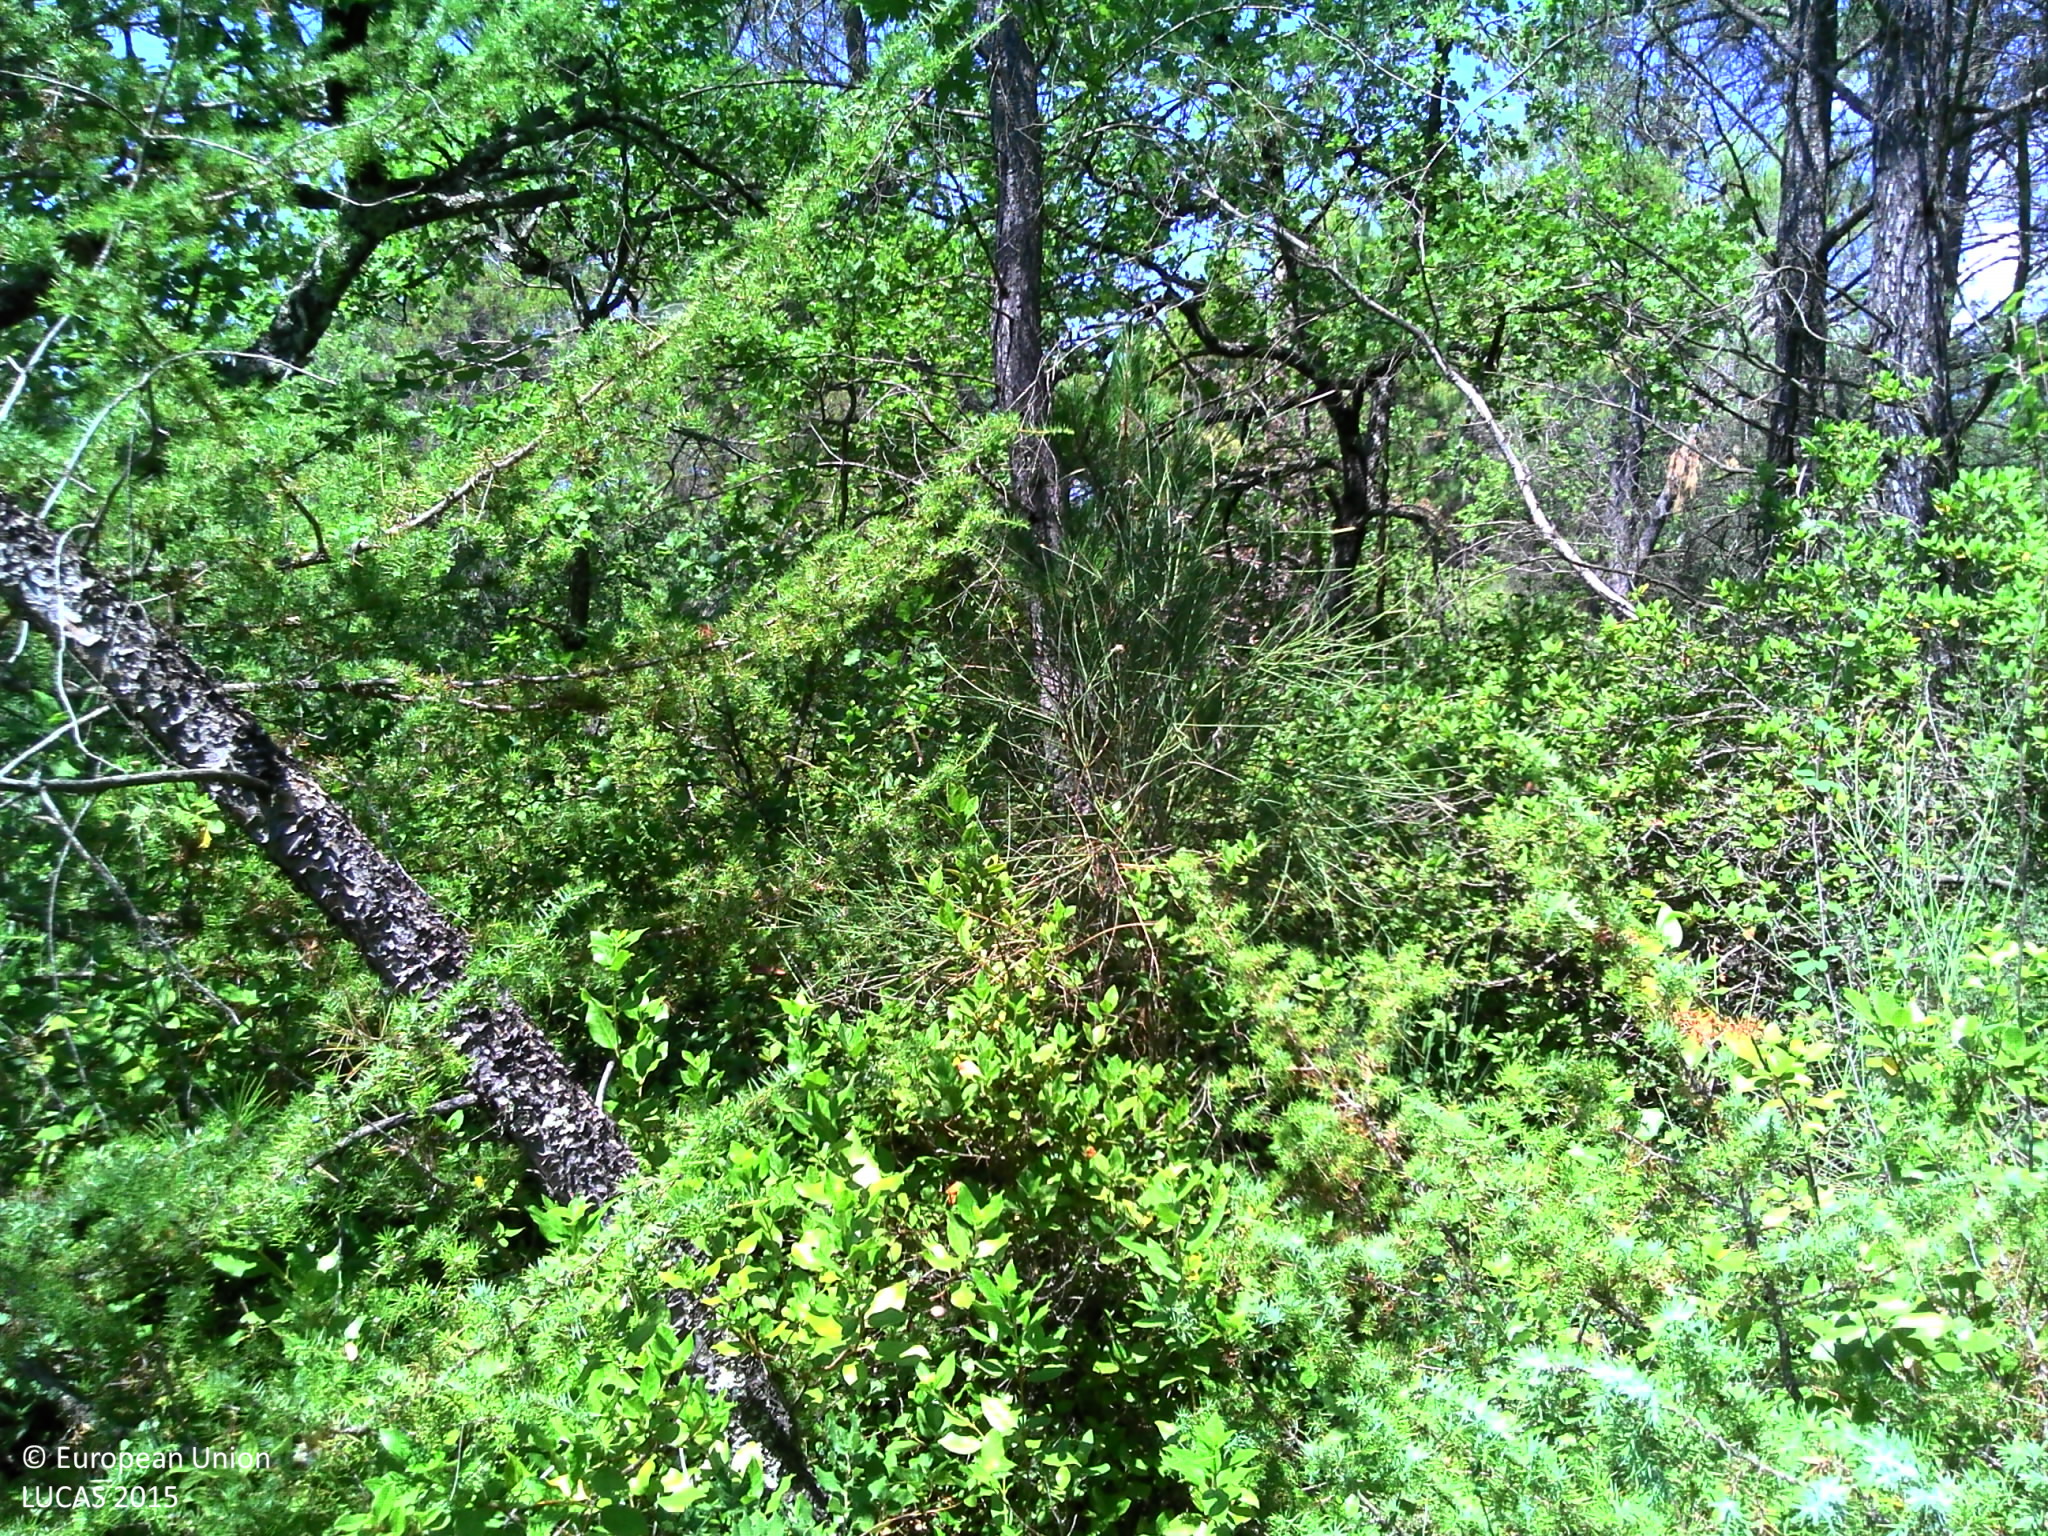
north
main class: Woodland
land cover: Pine dominated mixed woodland
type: coniferous forest of the mediterranean region
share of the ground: 50 - 75 %
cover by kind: coniferous forest trees 40 %, broadleaved forest trees 30 %, shrubs 20 %, herbaceous plants 5 %, lichens and mosses 5 %
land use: Forestry
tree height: > 5 m
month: July
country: FR
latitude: 44.0218
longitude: 5.1804
